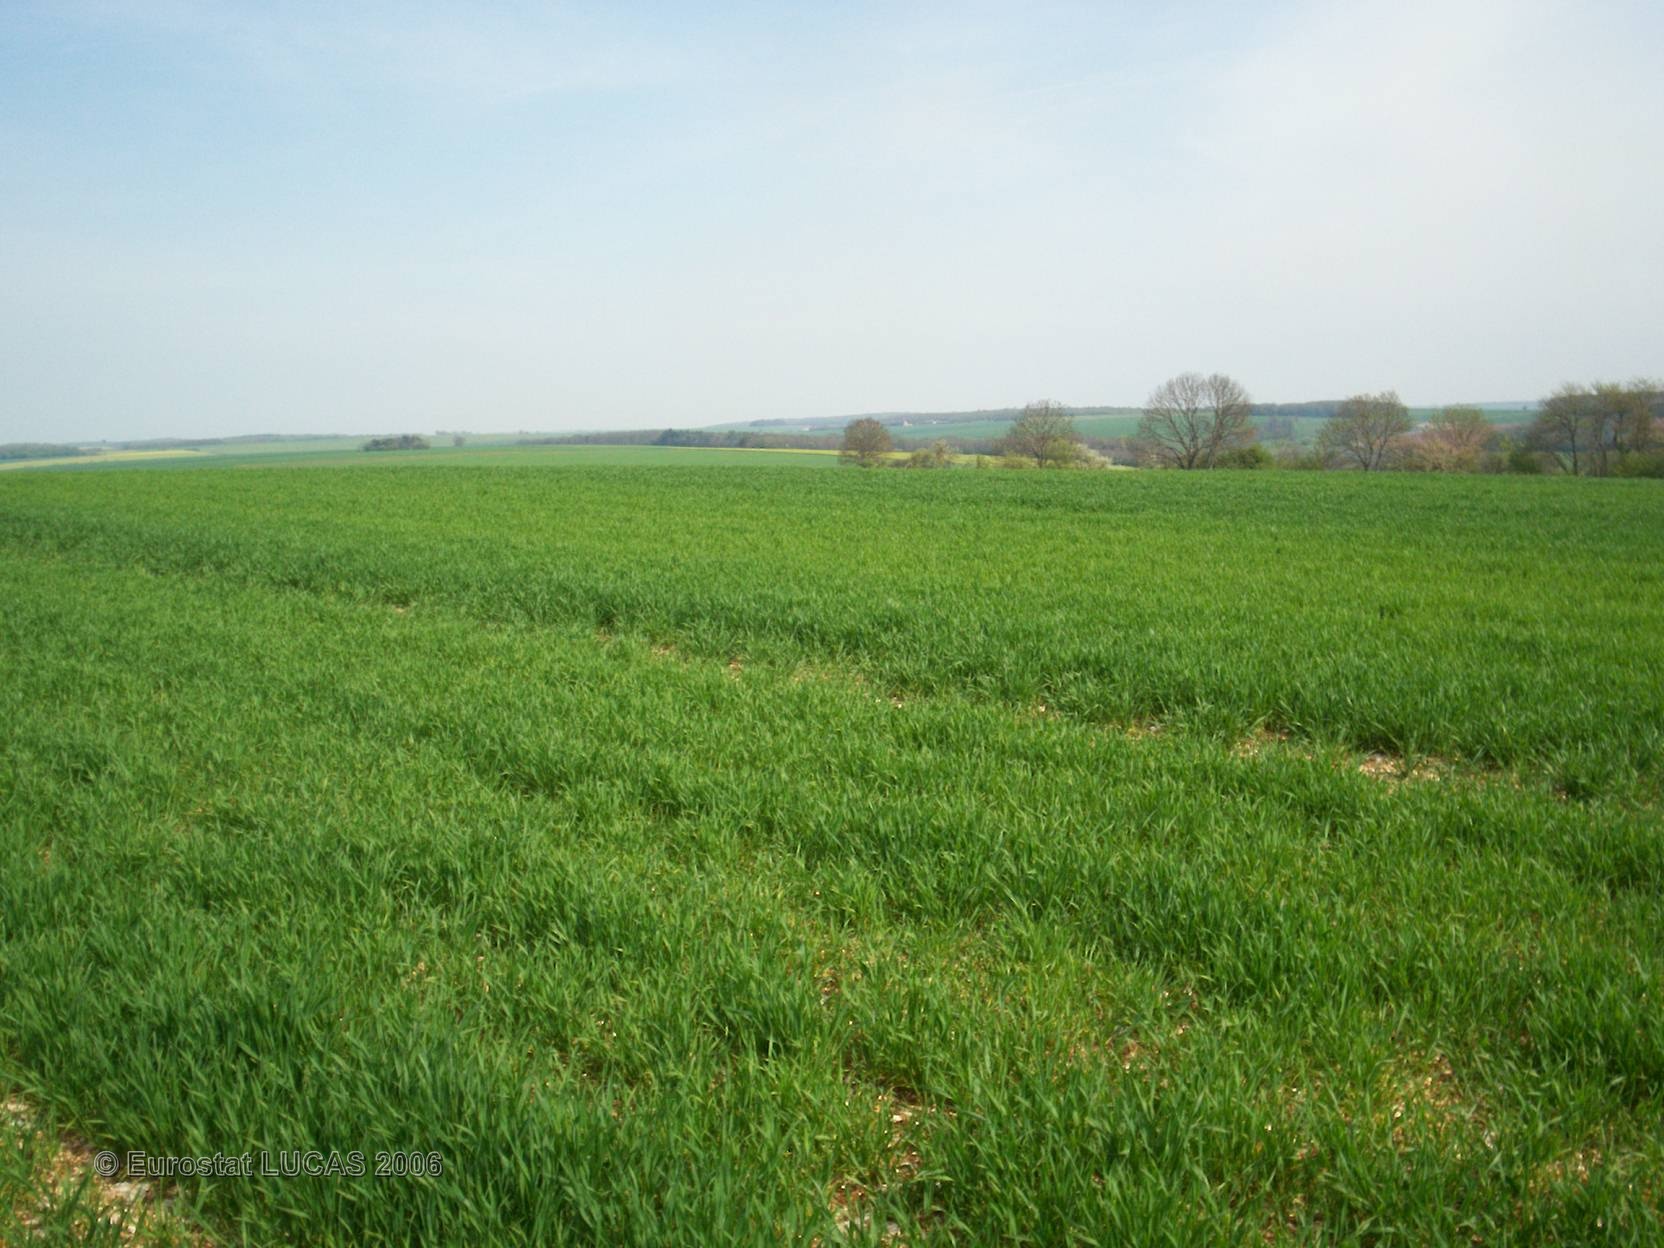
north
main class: Cropland
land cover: Common wheat
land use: Agriculture (excluding fallow land and kitchen gardens)
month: May
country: FR
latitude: 47.6061
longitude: 4.6385
